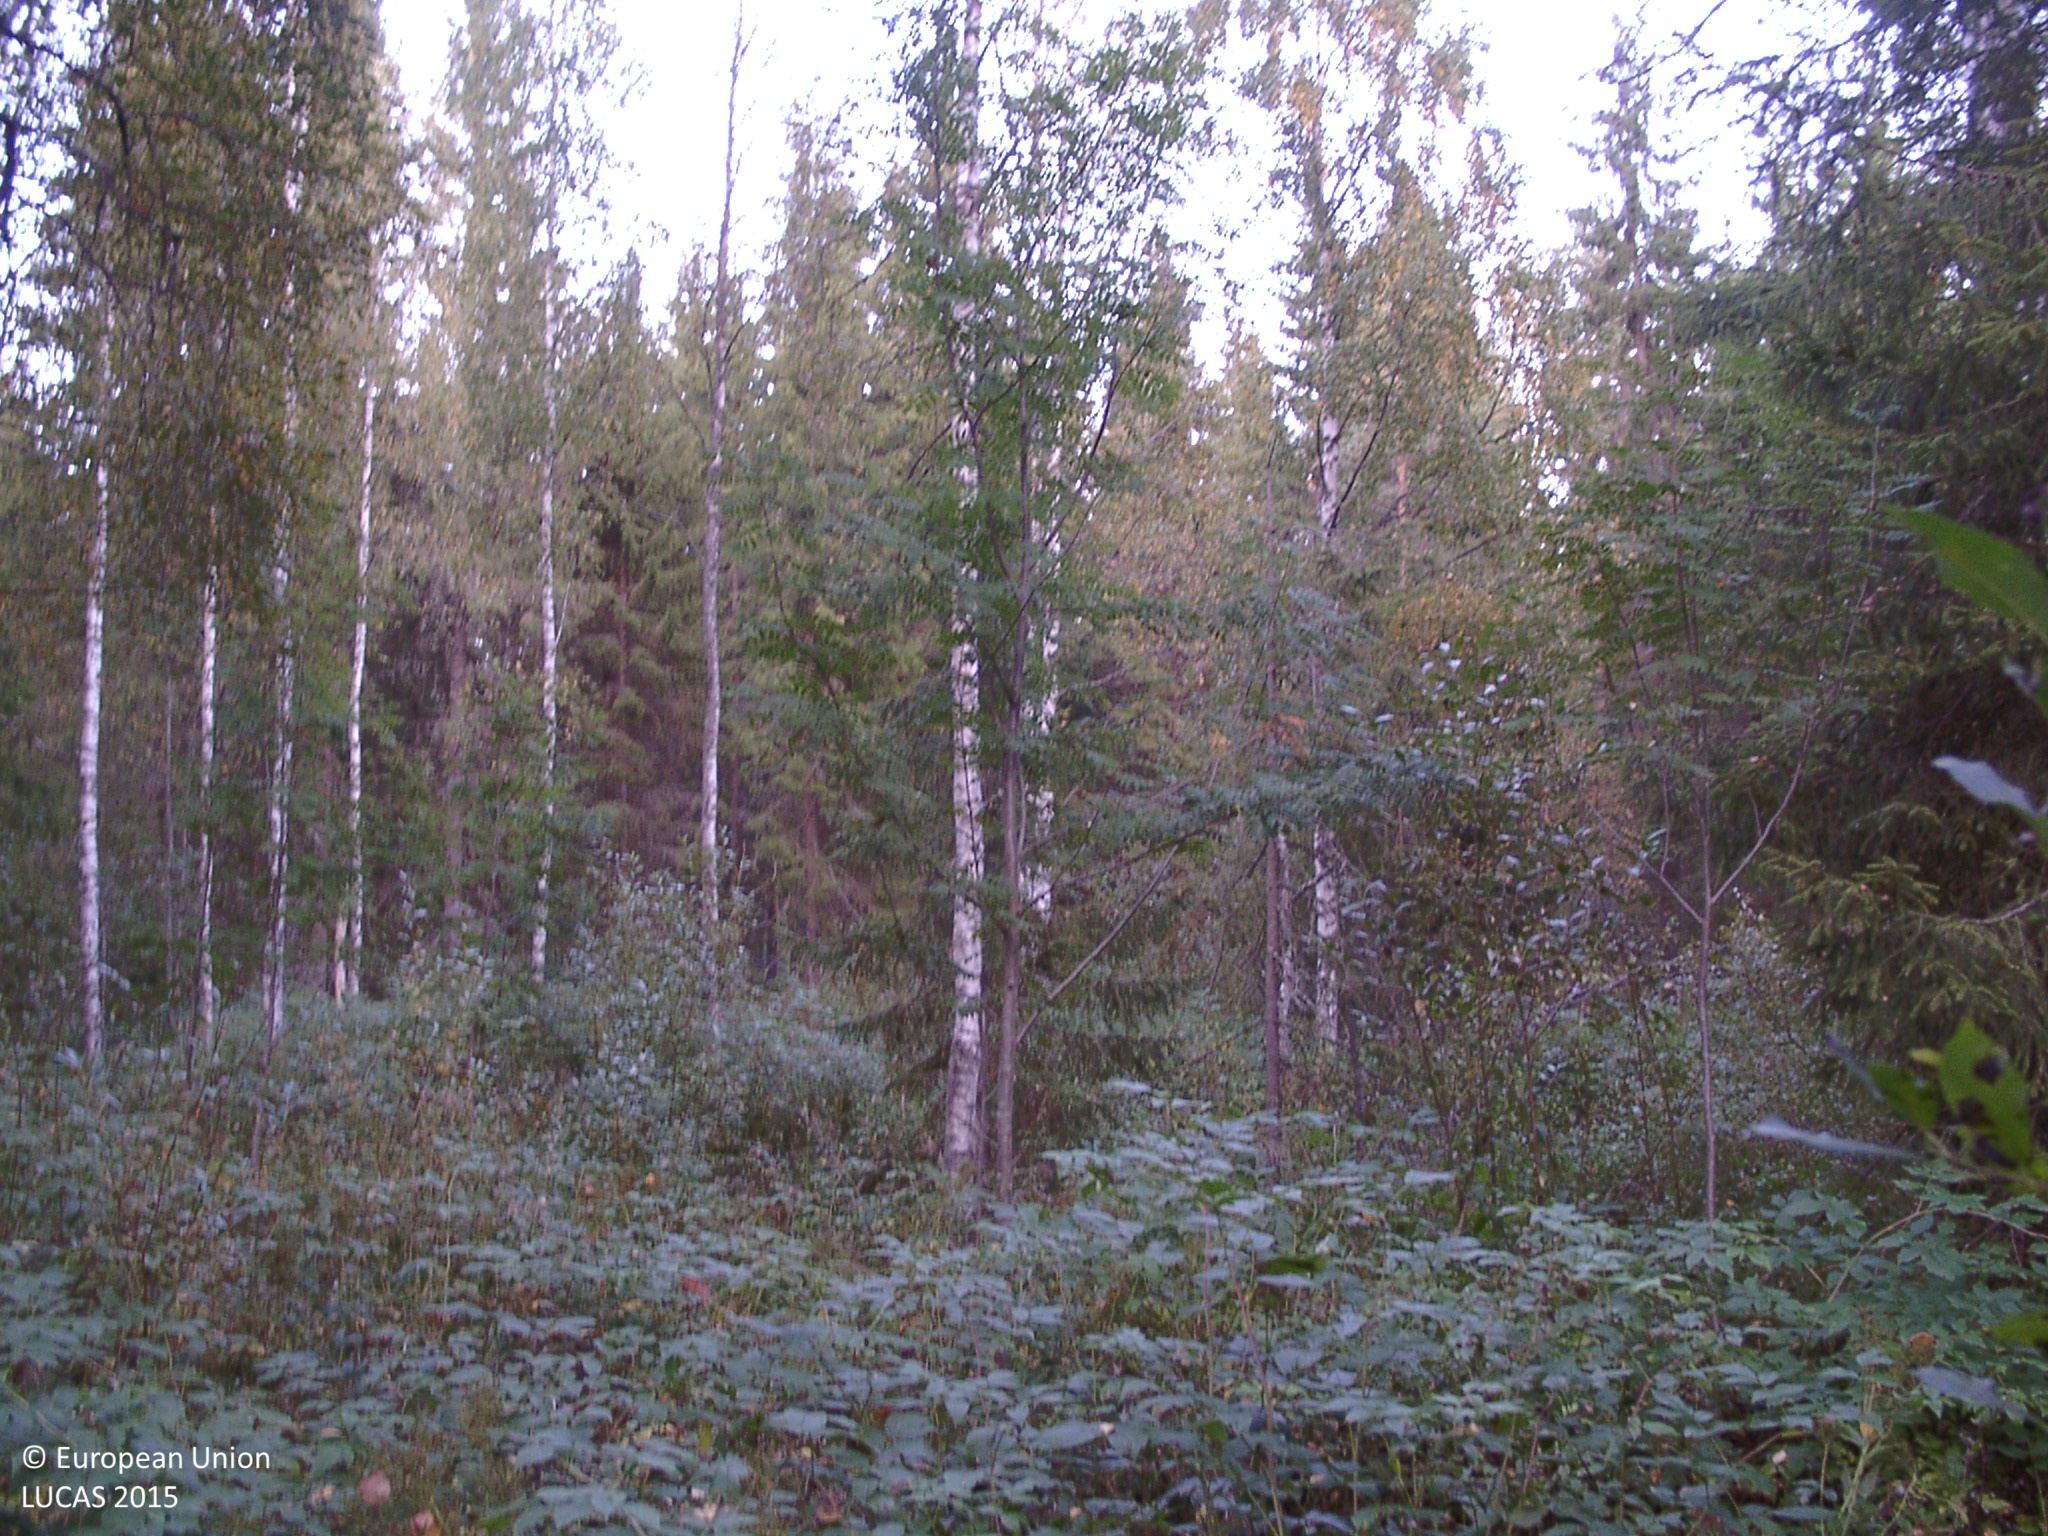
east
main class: Woodland
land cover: Spruce dominated mixed woodland
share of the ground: 25 - 50 %
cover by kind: shrubs 40 %, herbaceous plants 25 %, broadleaved forest trees 20 %, coniferous forest trees 15 %
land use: Forestry
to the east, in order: Spruce dominated mixed woodland; Ditches and canals; Spruce dominated mixed woodland; Shrubland with sparse tree cover; Spruce dominated coniferous woodland; Ditches and canals; Spruce dominated coniferous woodland; Other coniferous woodland; Spruce dominated coniferous woodland; Ditches and canals; Spruce dominated coniferous woodland
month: September
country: FI
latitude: 62.4316
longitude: 24.7574
